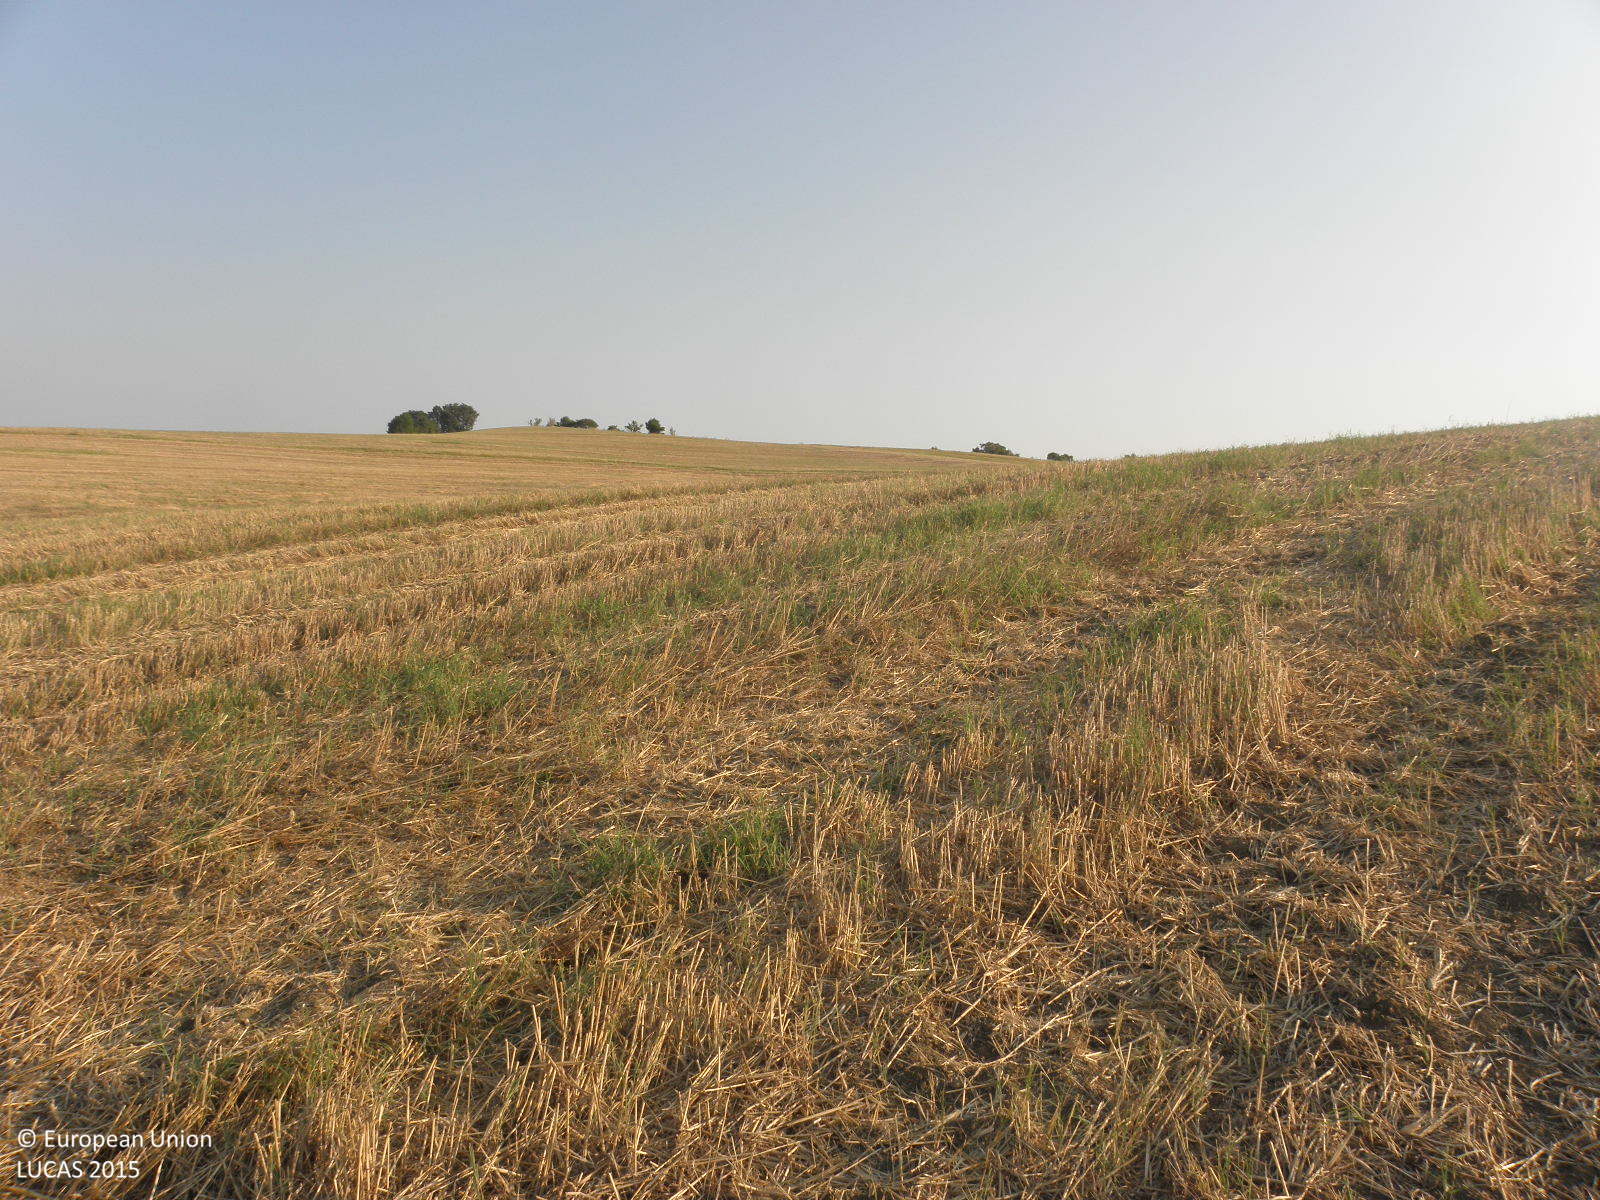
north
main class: Cropland
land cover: Durum wheat
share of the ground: > 75 %
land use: Agriculture (excluding fallow land and kitchen gardens)
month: July
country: GR
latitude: 40.3583
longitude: 22.5161
